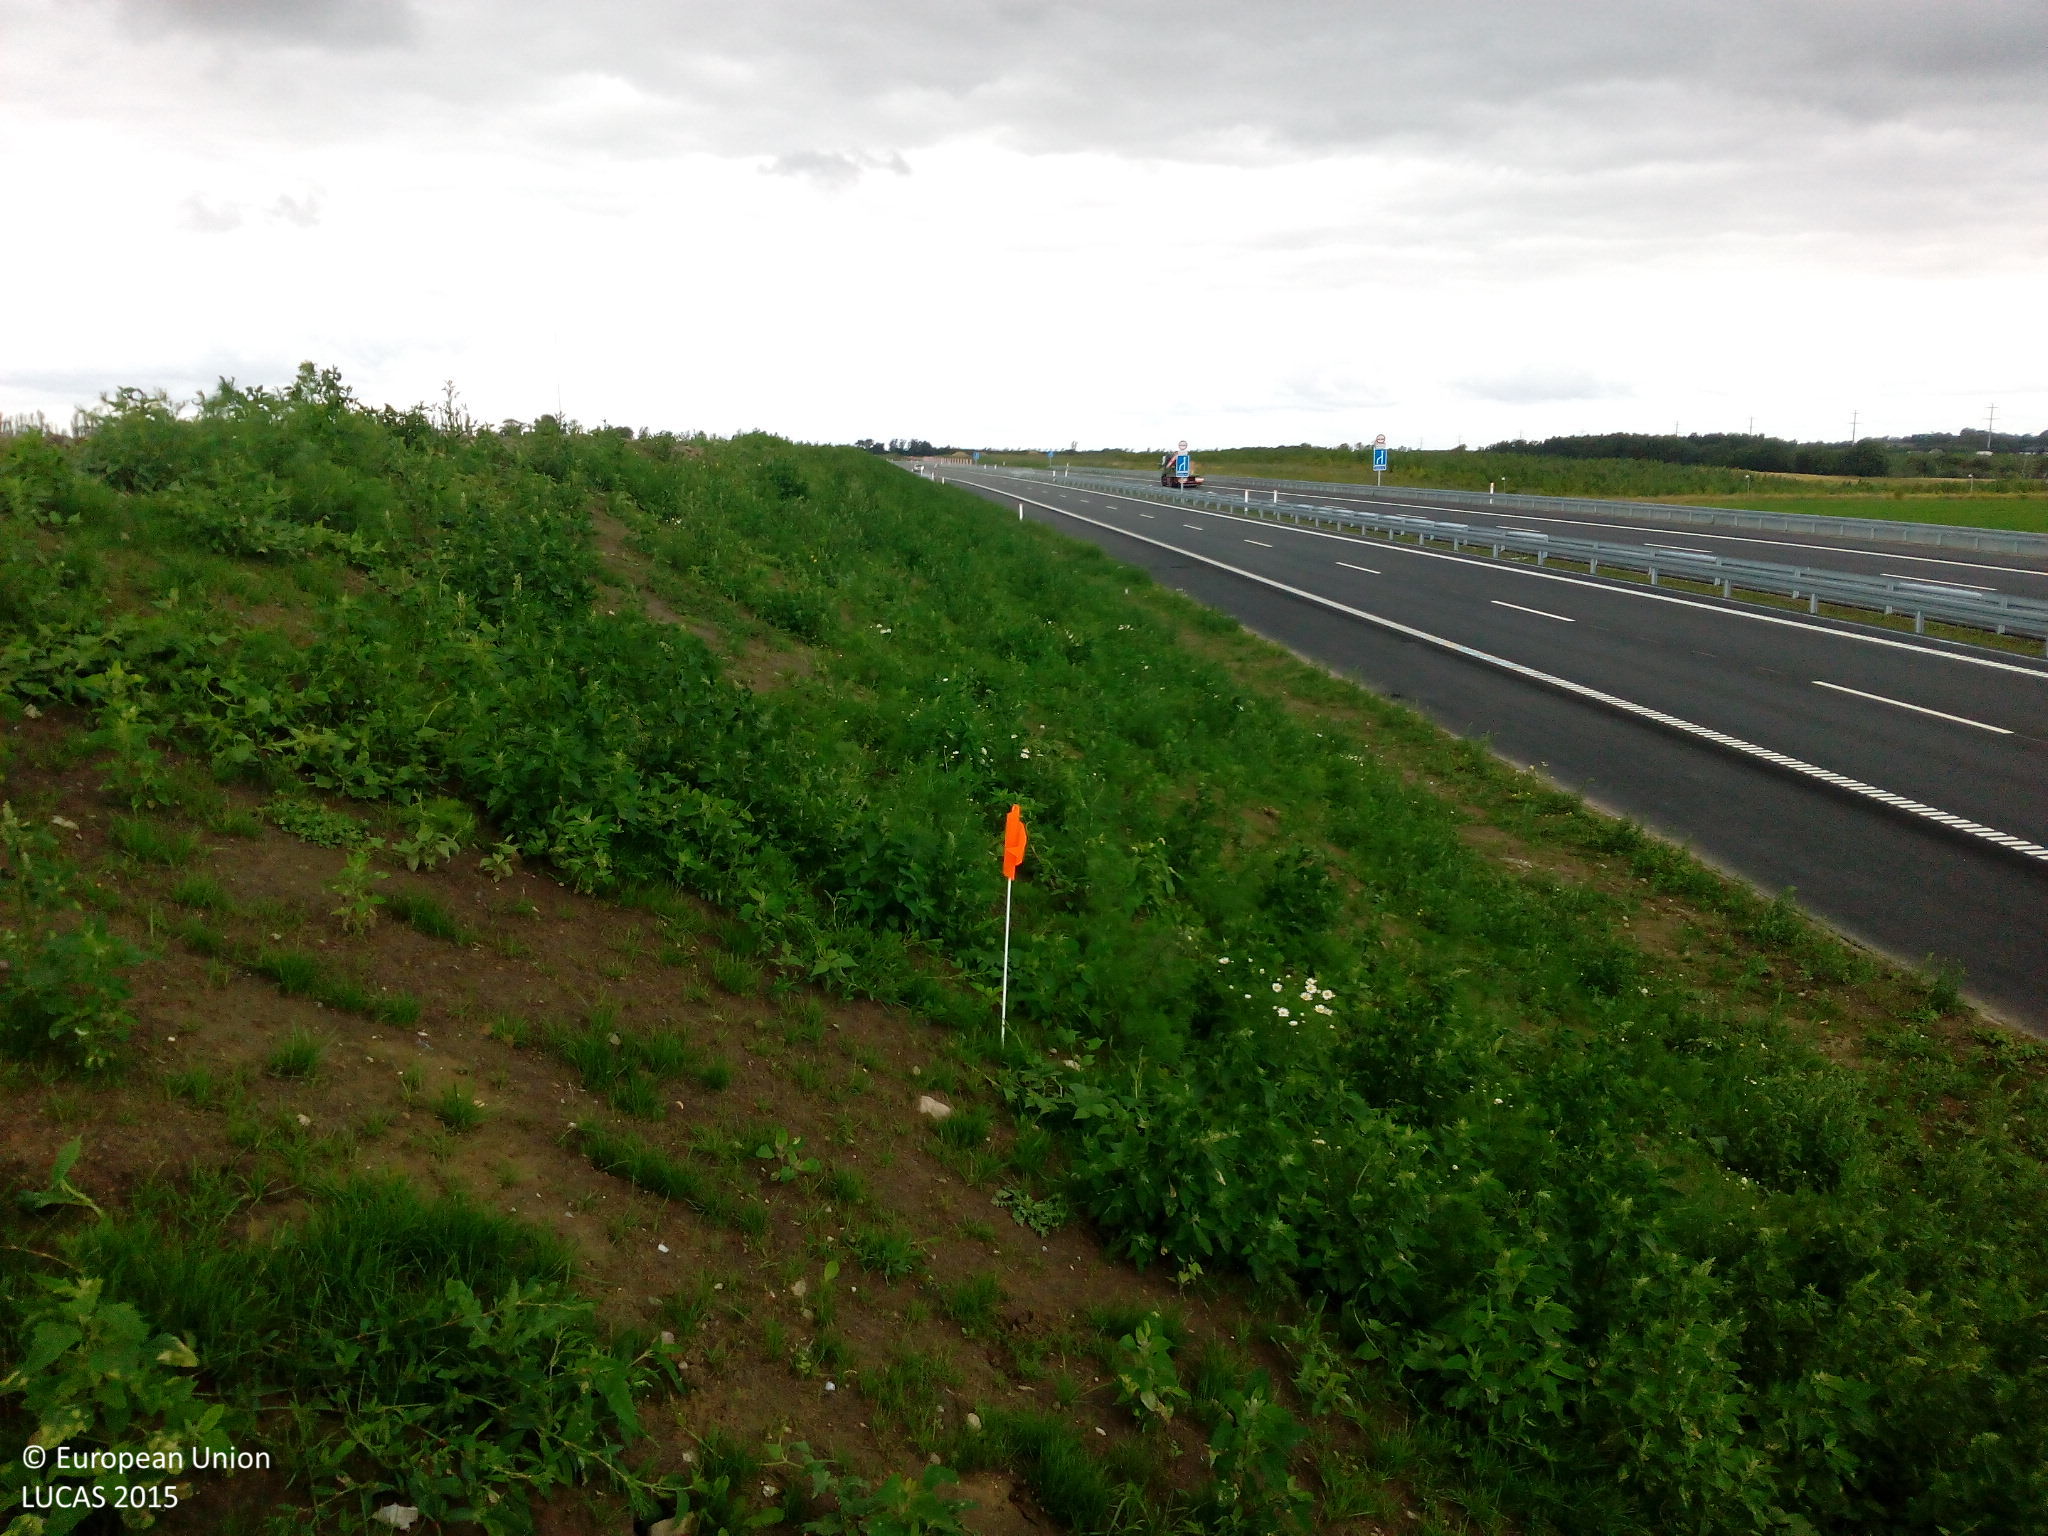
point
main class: Grassland
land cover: Spontaneously vegetated surfaces
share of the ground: > 75 %
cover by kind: herbaceous plants 80 %, unconsolidated bare surface 20 %
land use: Road transport
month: July
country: DK
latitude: 55.7175
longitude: 12.3063
